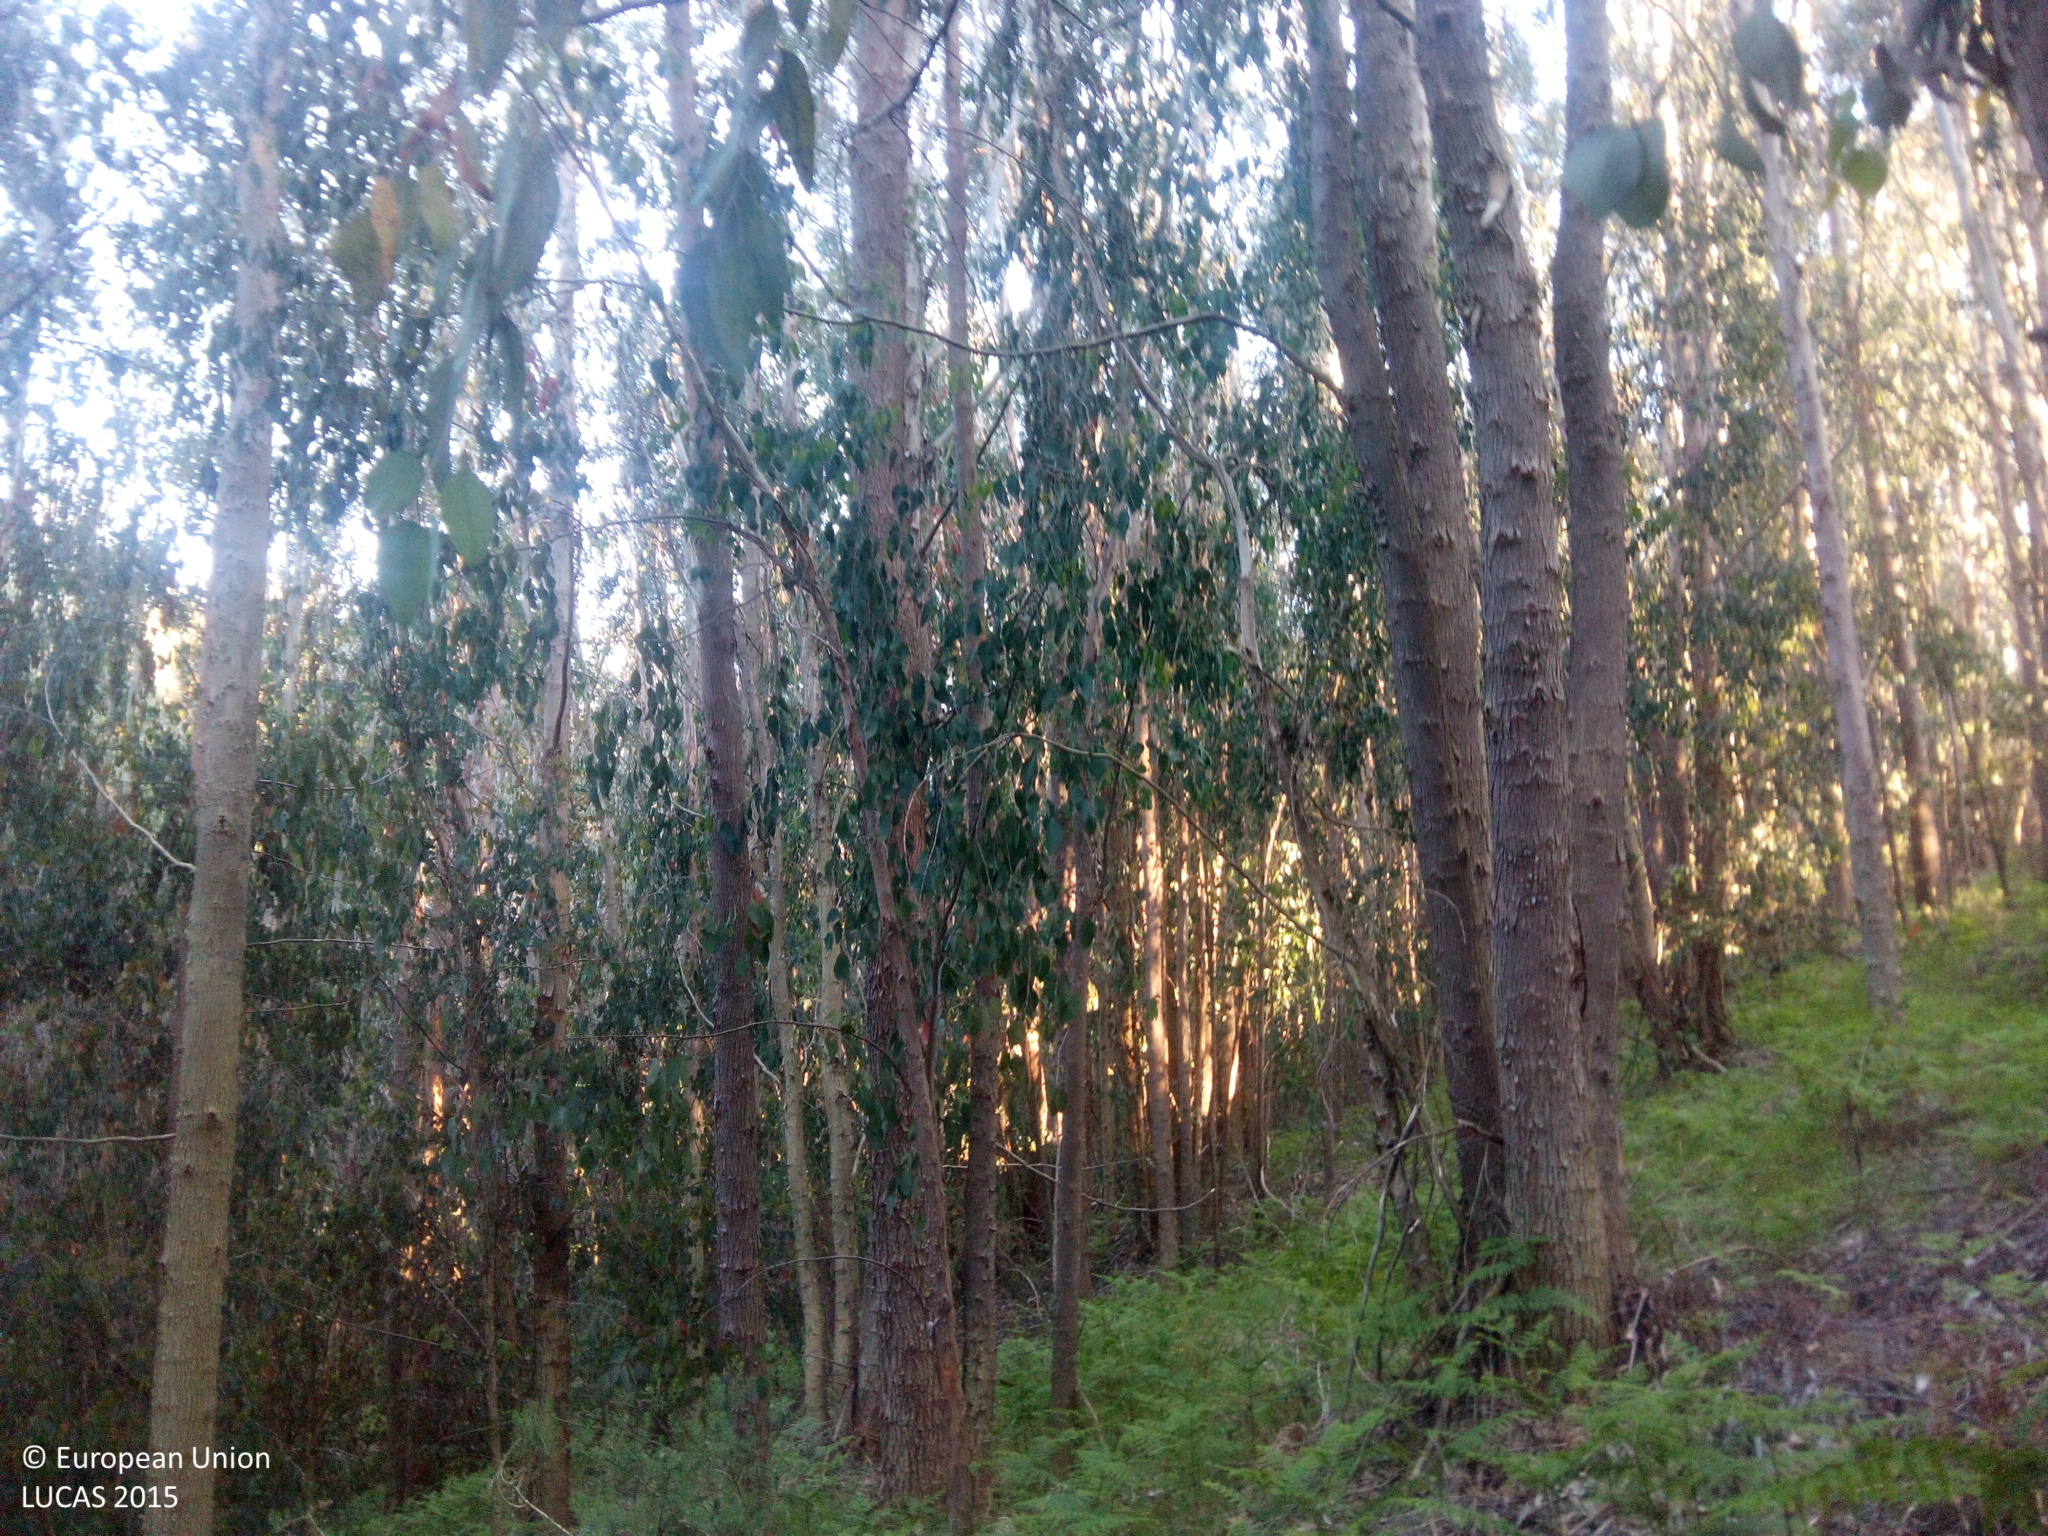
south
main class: Woodland
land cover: Broadleaved woodland
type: exotic forest
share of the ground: > 75 %
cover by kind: broadleaved forest trees 70 %, shrubs 20 %, herbaceous plants 10 %
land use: Forestry
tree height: > 5 m
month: June
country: ES
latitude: 42.2218
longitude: -8.3218
